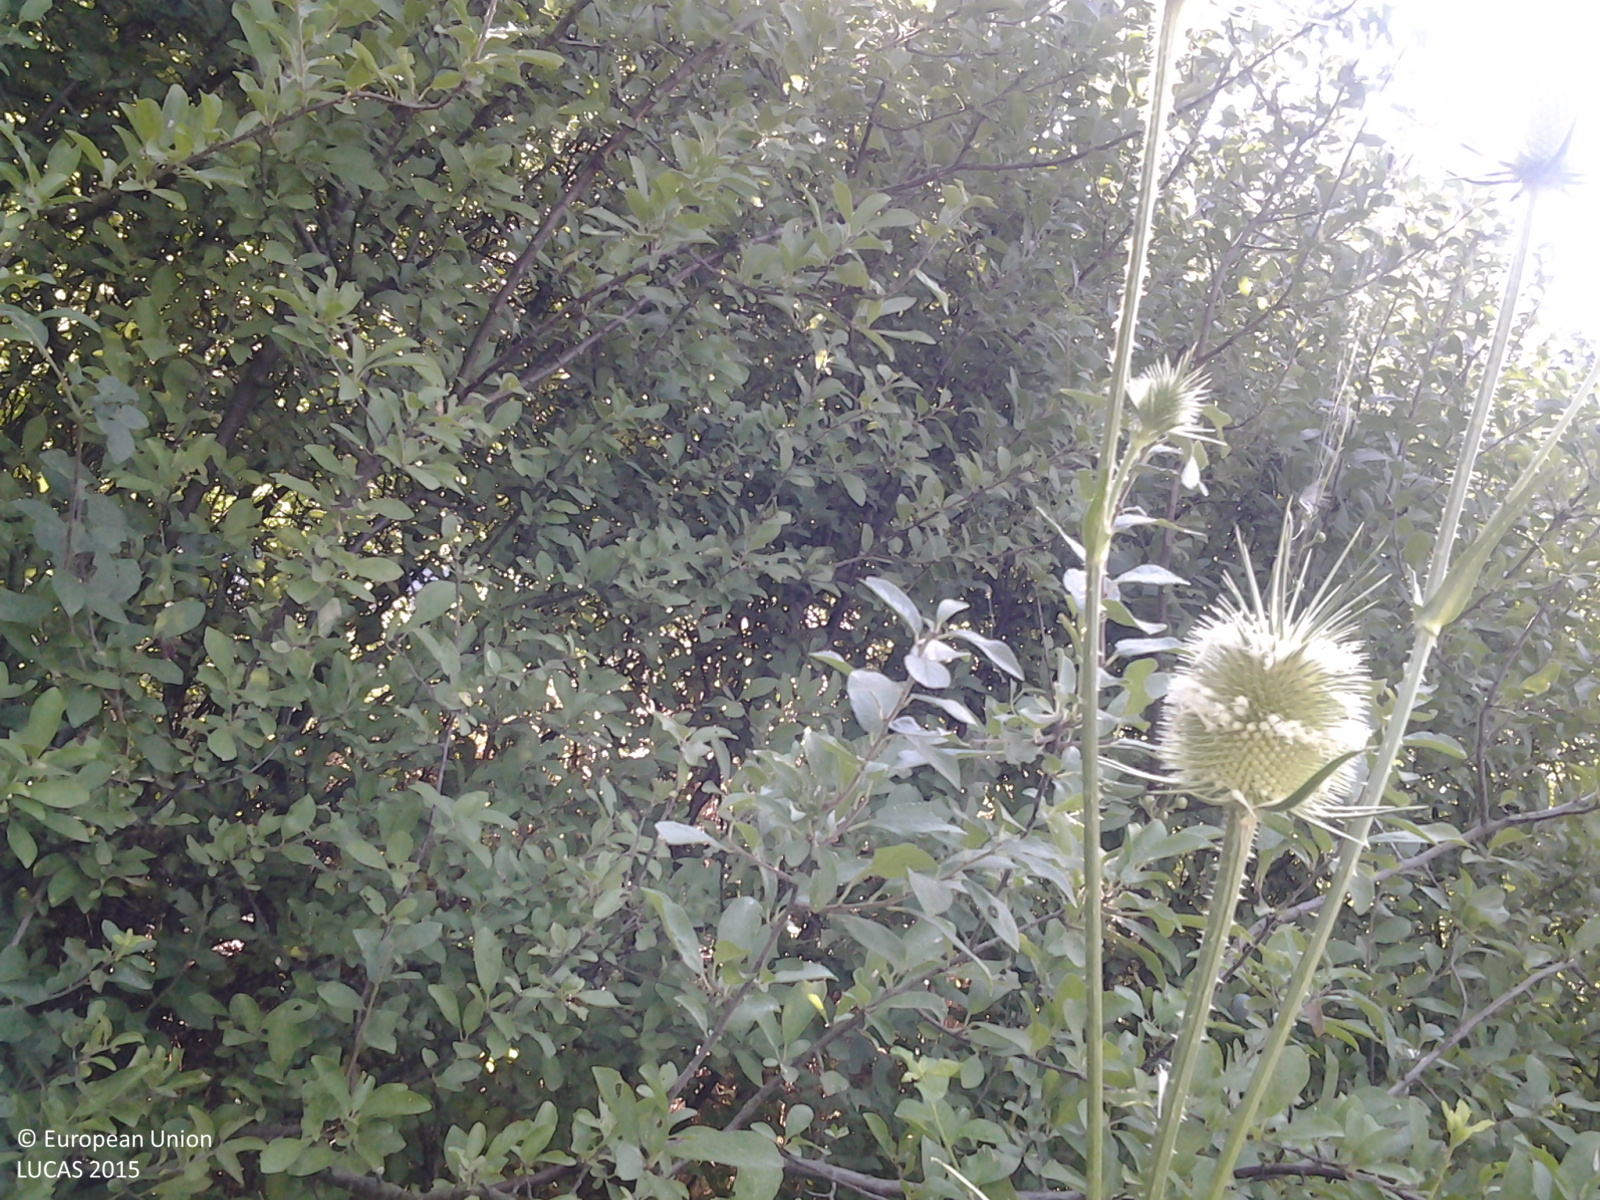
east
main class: Woodland
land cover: Broadleaved woodland
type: mesophytic deciduous forest
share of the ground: > 75 %
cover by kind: broadleaved forest trees 80 %, shrubs 10 %, herbaceous plants 10 %
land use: Forestry
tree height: > 5 m
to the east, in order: Broadleaved woodland; Paved roads, cycling and walking lanes; Grass margins; Lines of trees; Grass margins; Maize; Grass margins; Ditches and canals; Grass margins; Common wheat
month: July
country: HU
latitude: 46.7931
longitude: 21.2372
